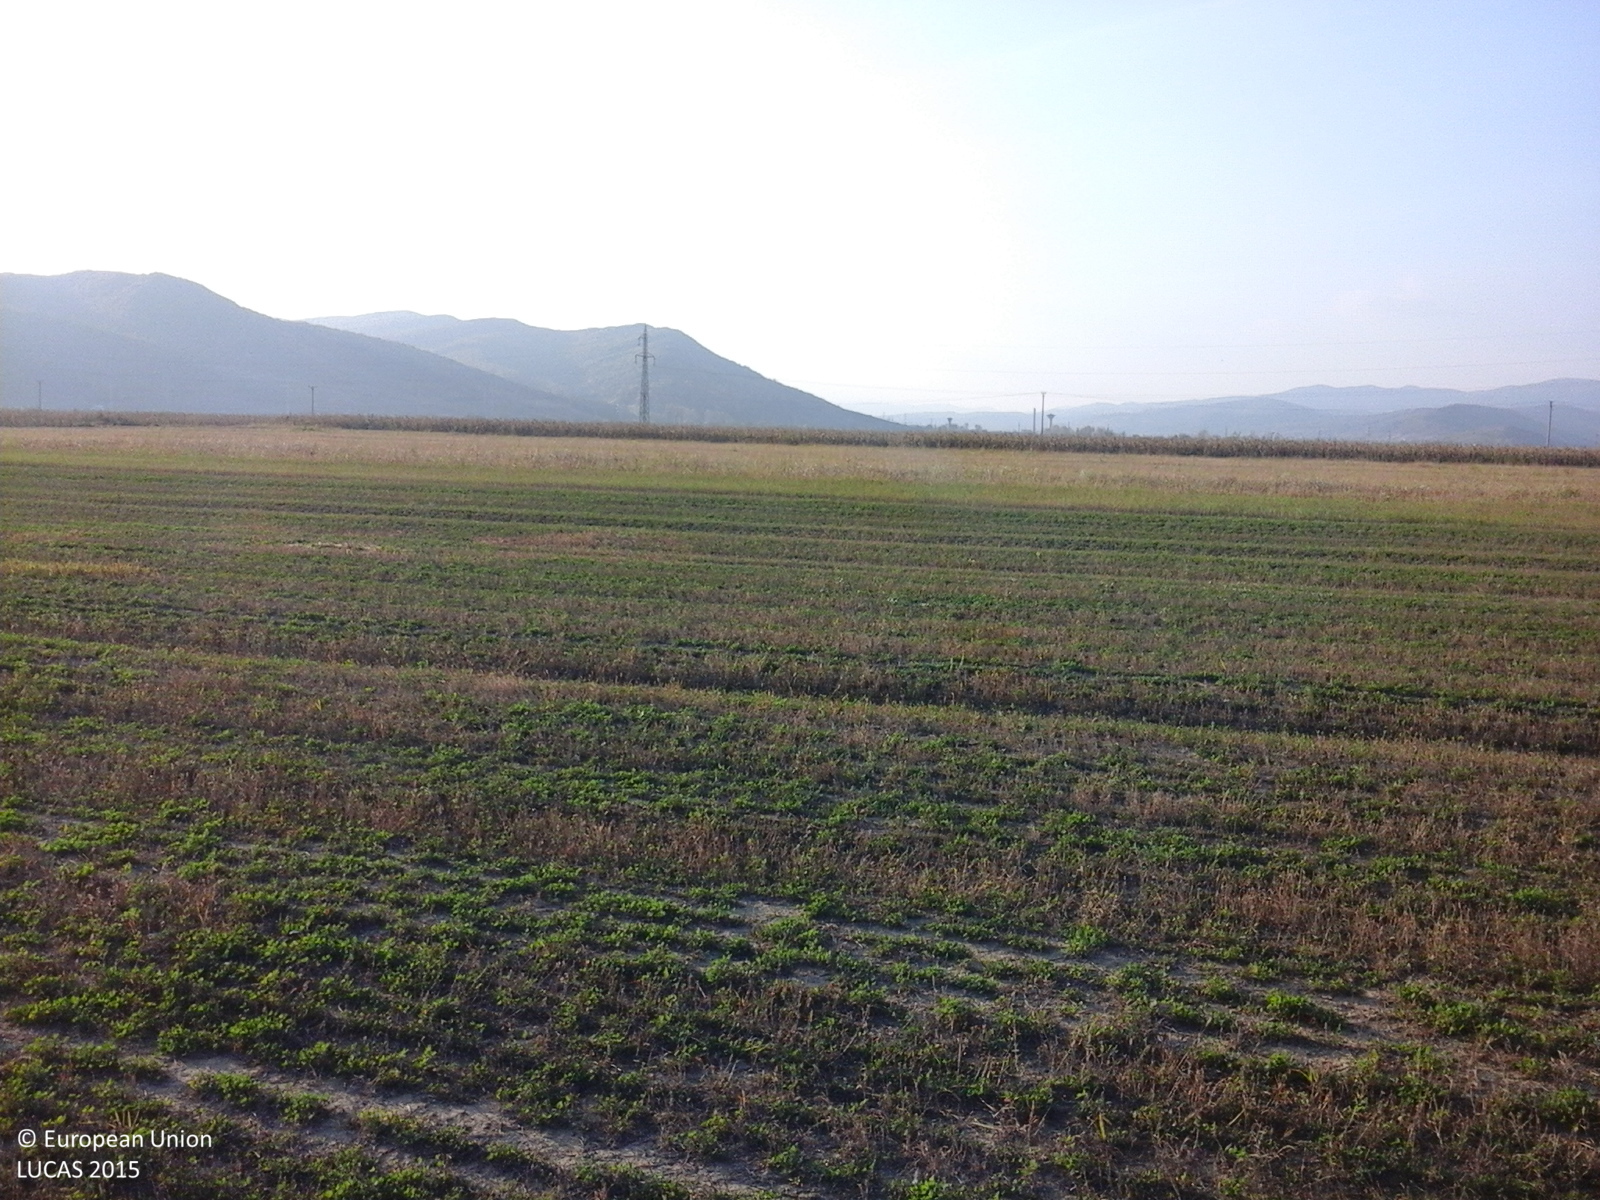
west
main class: Cropland
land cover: Lucerne
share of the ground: 50 - 75 %
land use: Agriculture (excluding fallow land and kitchen gardens)
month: October
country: RO
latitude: 45.2638
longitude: 26.7094
